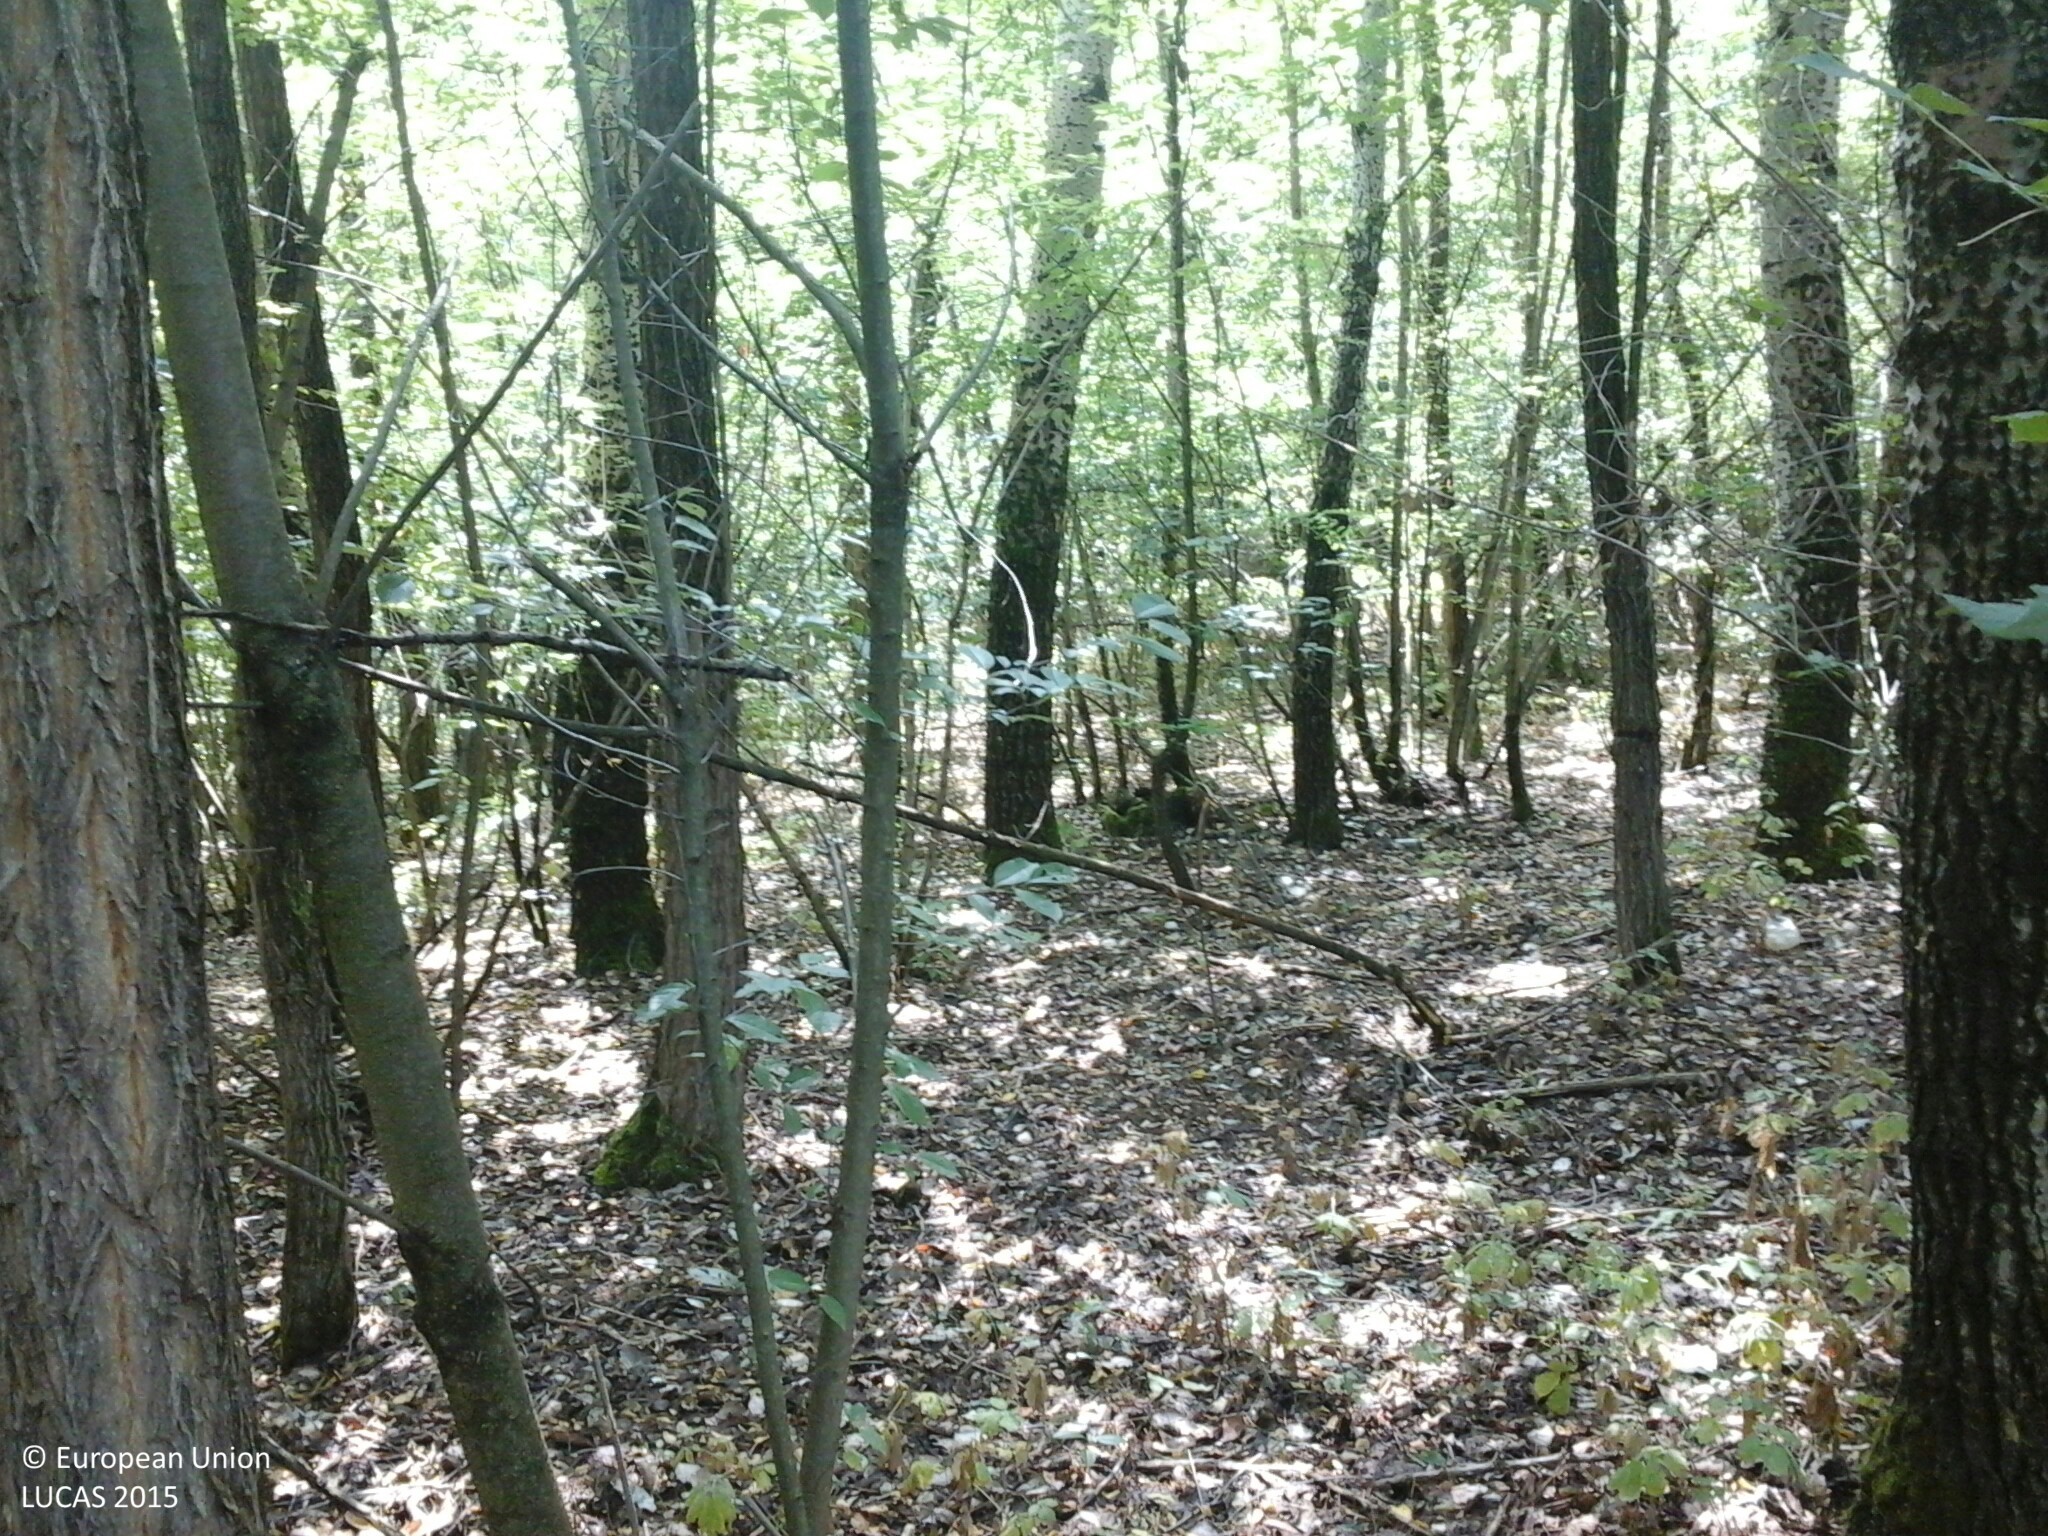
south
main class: Woodland
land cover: Broadleaved woodland
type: mesophytic deciduous forest
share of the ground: > 75 %
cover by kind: broadleaved forest trees 100 %
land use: Forestry
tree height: > 5 m
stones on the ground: < 10 %
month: July
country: HU
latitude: 48.2329
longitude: 22.2135
